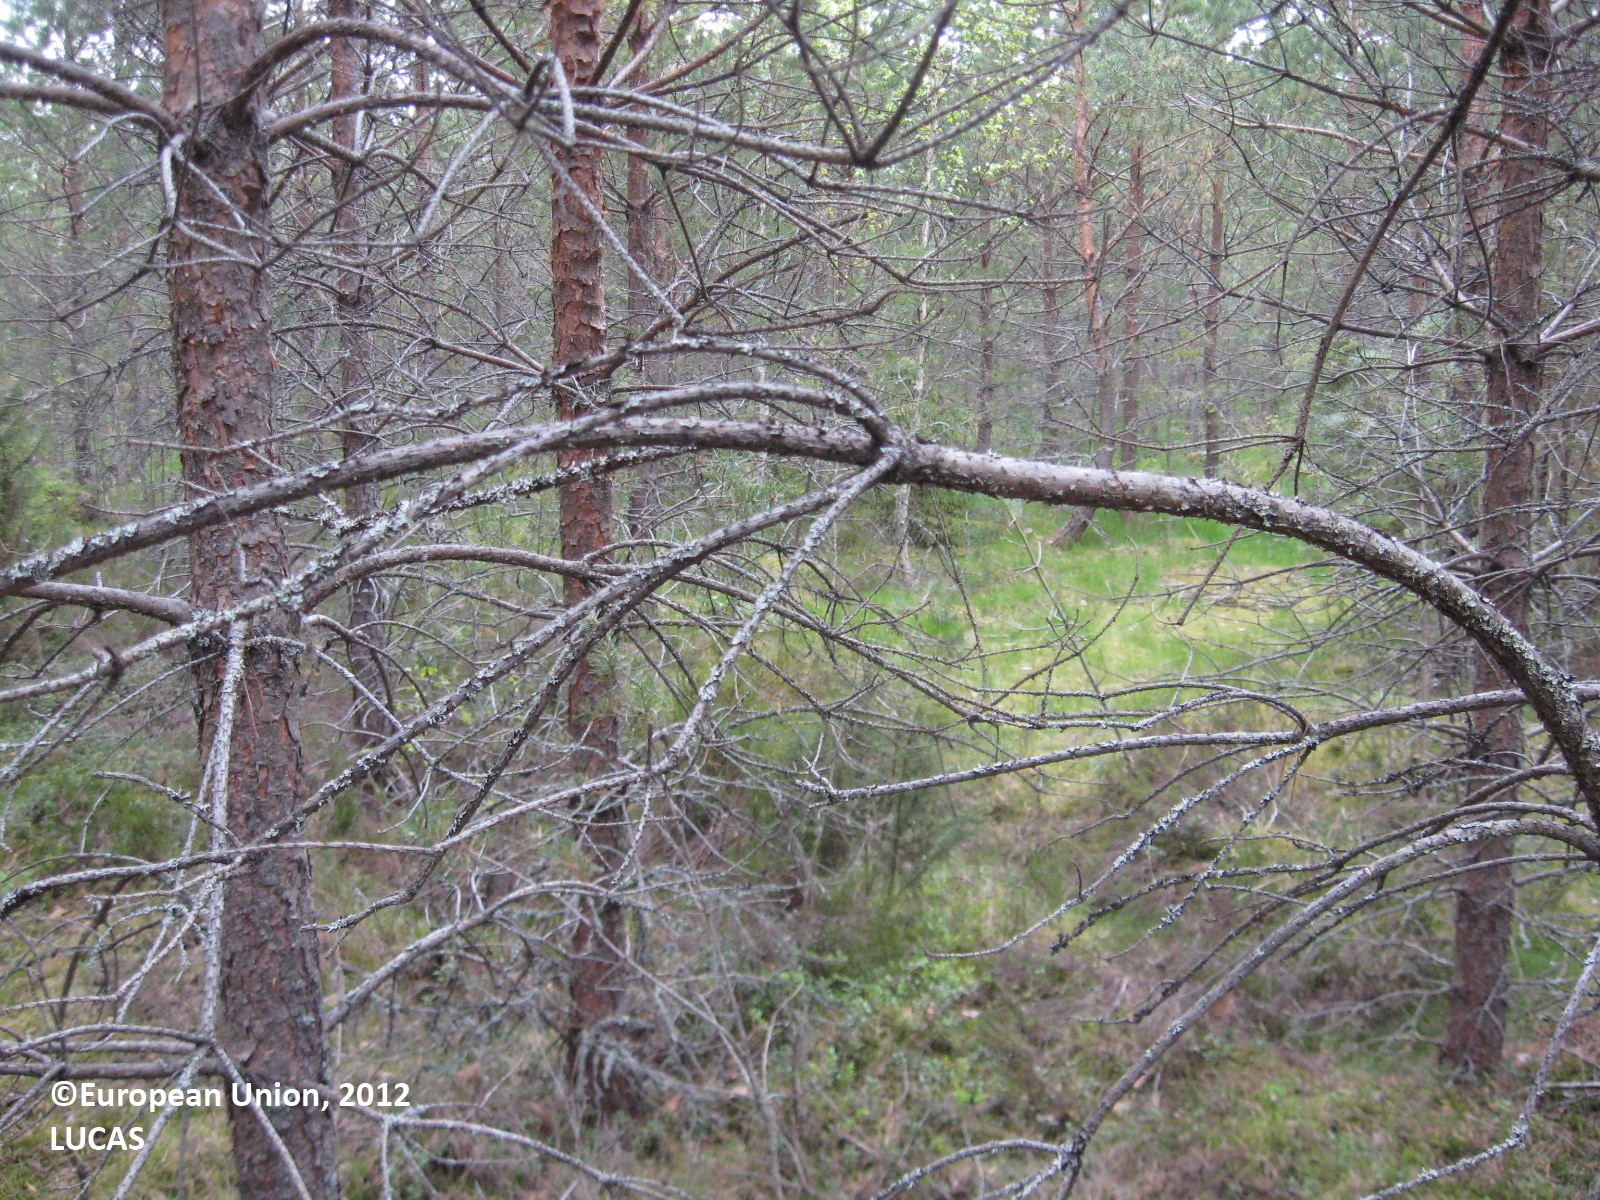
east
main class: Woodland
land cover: Pine dominated coniferous woodland
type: boreal forest
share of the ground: > 75 %
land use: Forestry
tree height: > 5 m
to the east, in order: Pine dominated coniferous woodland; Paved roads, cycling and walking lanes; Pine dominated coniferous woodland; Lichens and moss
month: May
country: FI
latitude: 61.7687
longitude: 22.8197
